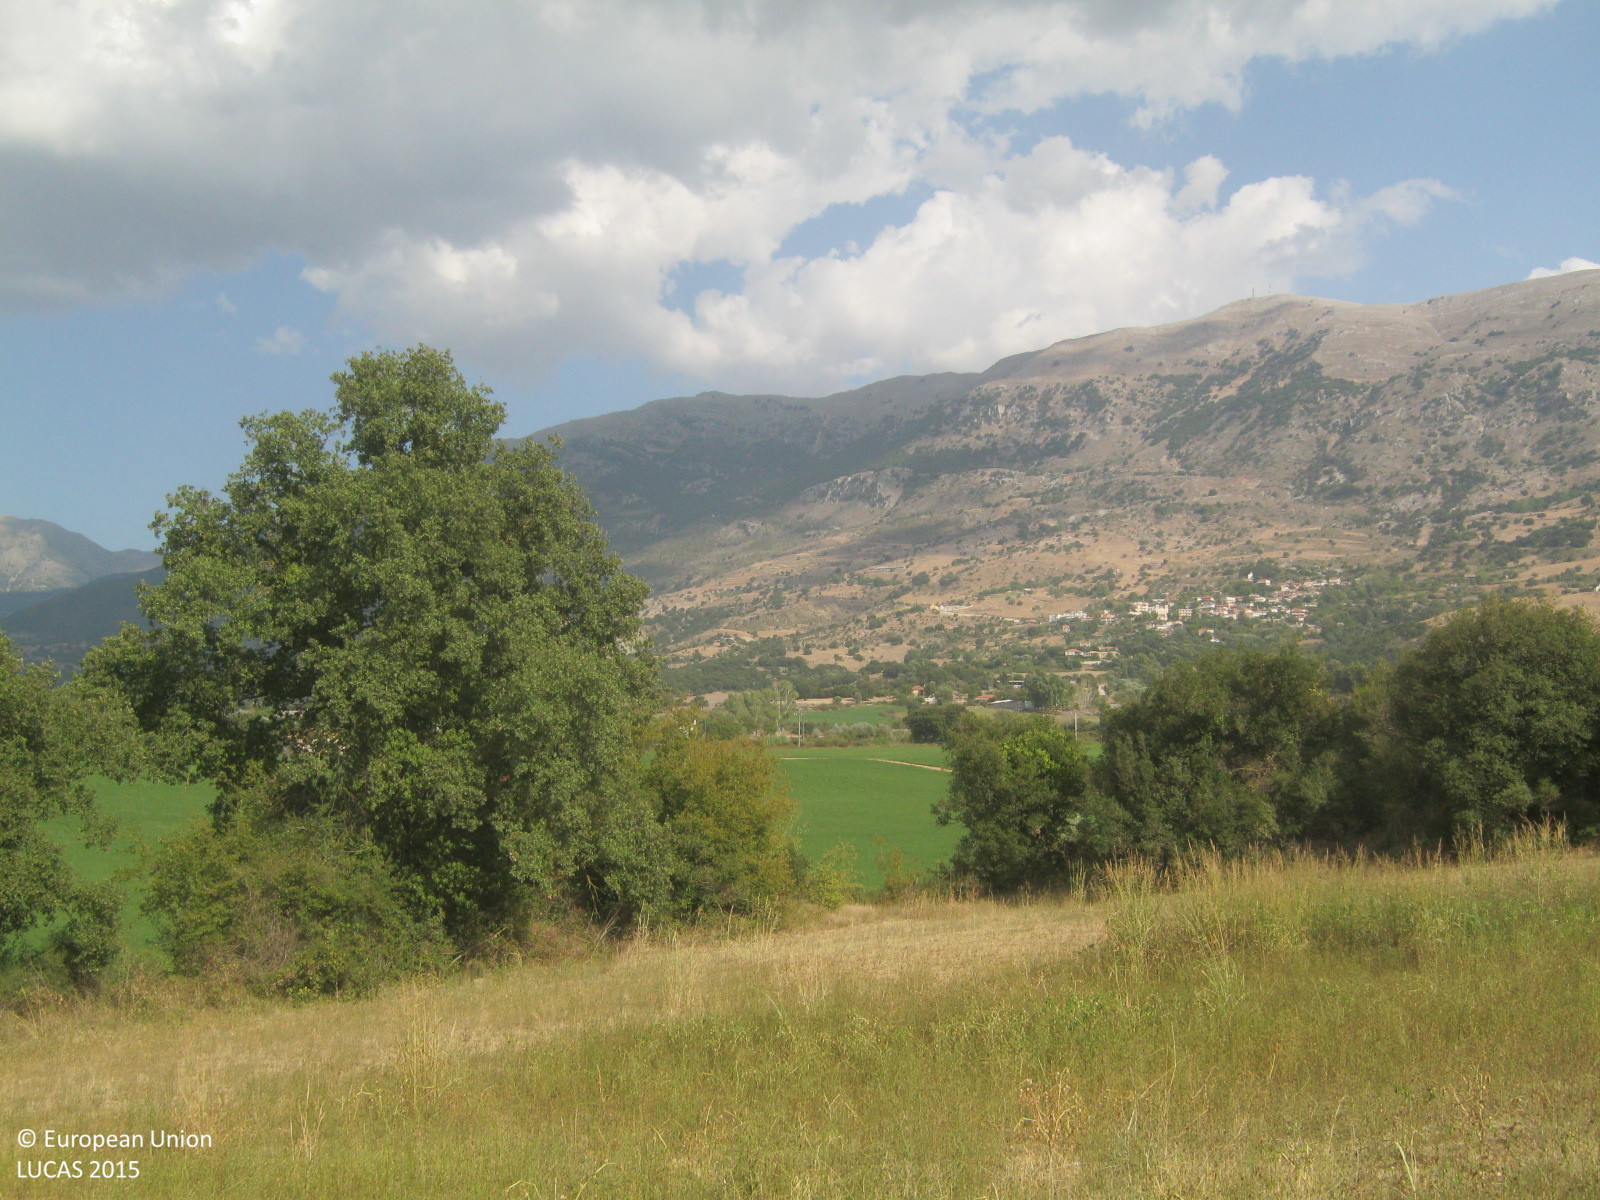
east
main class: Grassland
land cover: Spontaneously vegetated surfaces
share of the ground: 50 - 75 %
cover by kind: herbaceous plants 70 %, unconsolidated bare surface 30 %
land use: Fallow land
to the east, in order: Spontaneously vegetated surfaces; Broadleaved woodland; Ditches and canals; Abandoned hedges; Clovers; Abandoned hedges; Rivers and streams; Abandoned hedges; Clovers
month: September
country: GR
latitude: 37.8875
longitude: 21.6628
